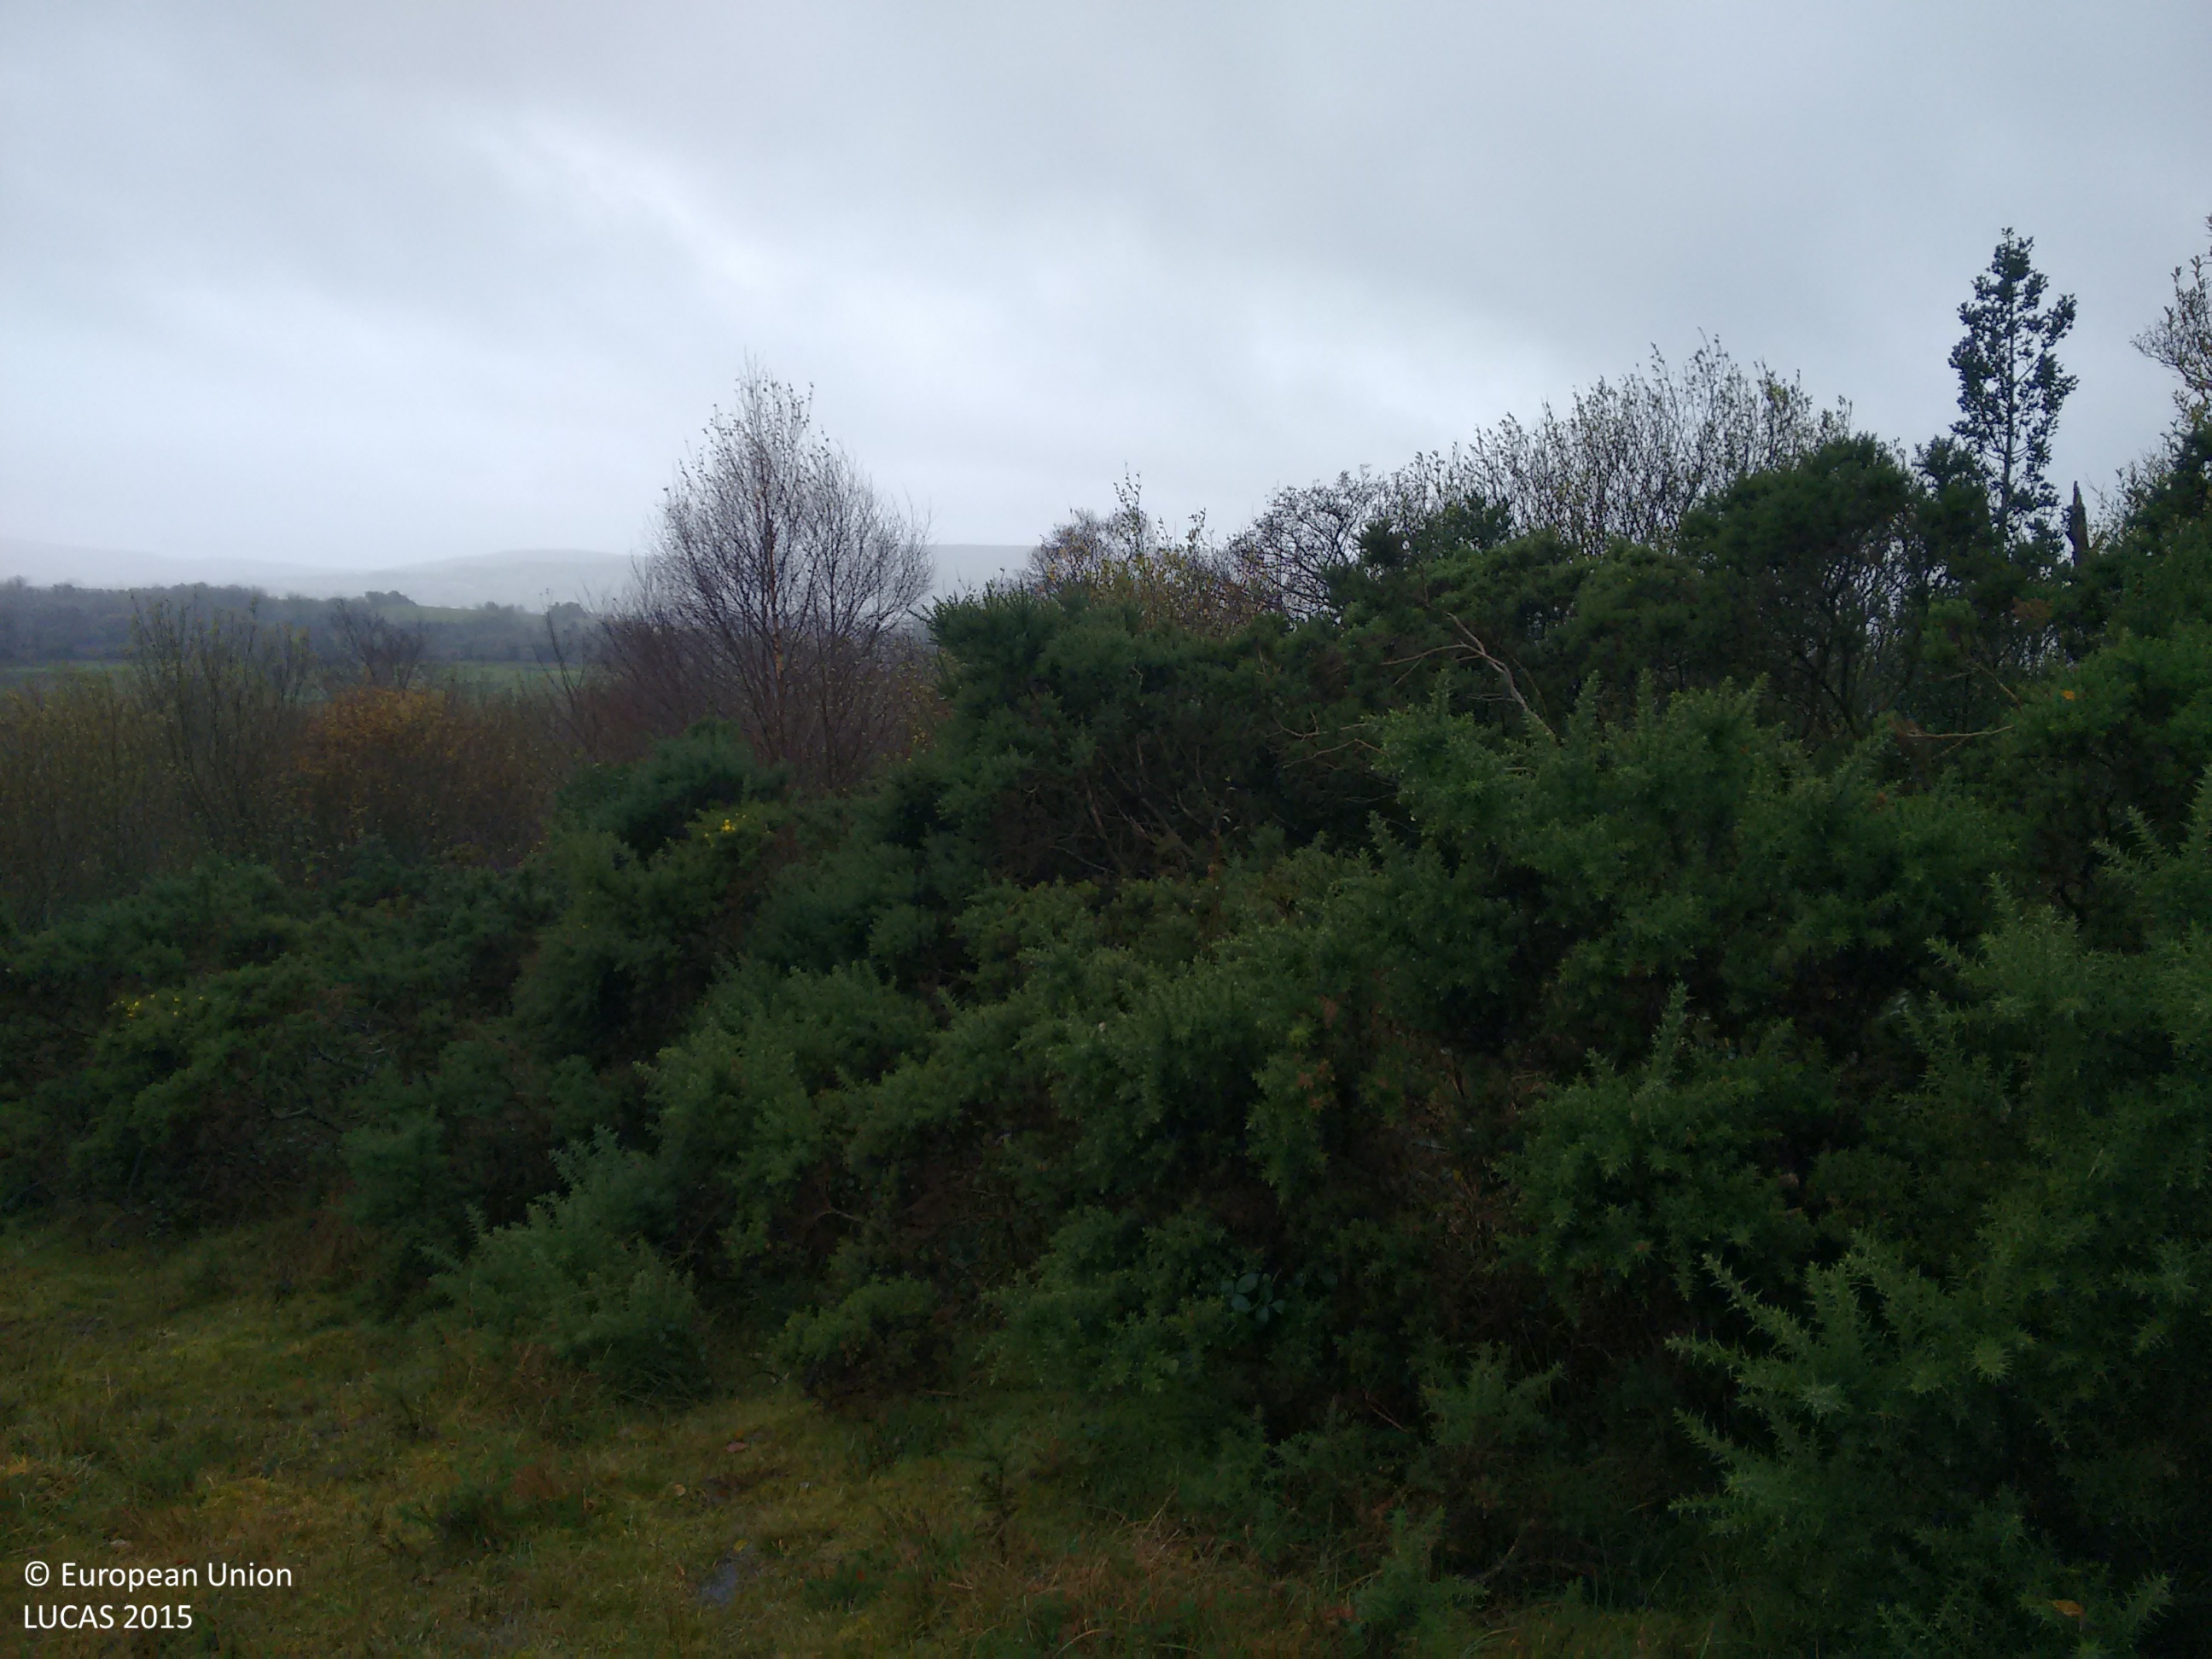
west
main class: Woodland
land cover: Broadleaved woodland
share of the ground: > 75 %
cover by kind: broadleaved forest trees 80 %, shrubs 10 %, herbaceous plants 10 %
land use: Semi-natural and natural areas not in use
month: November
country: IE
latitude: 54.0603
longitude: -8.2886
